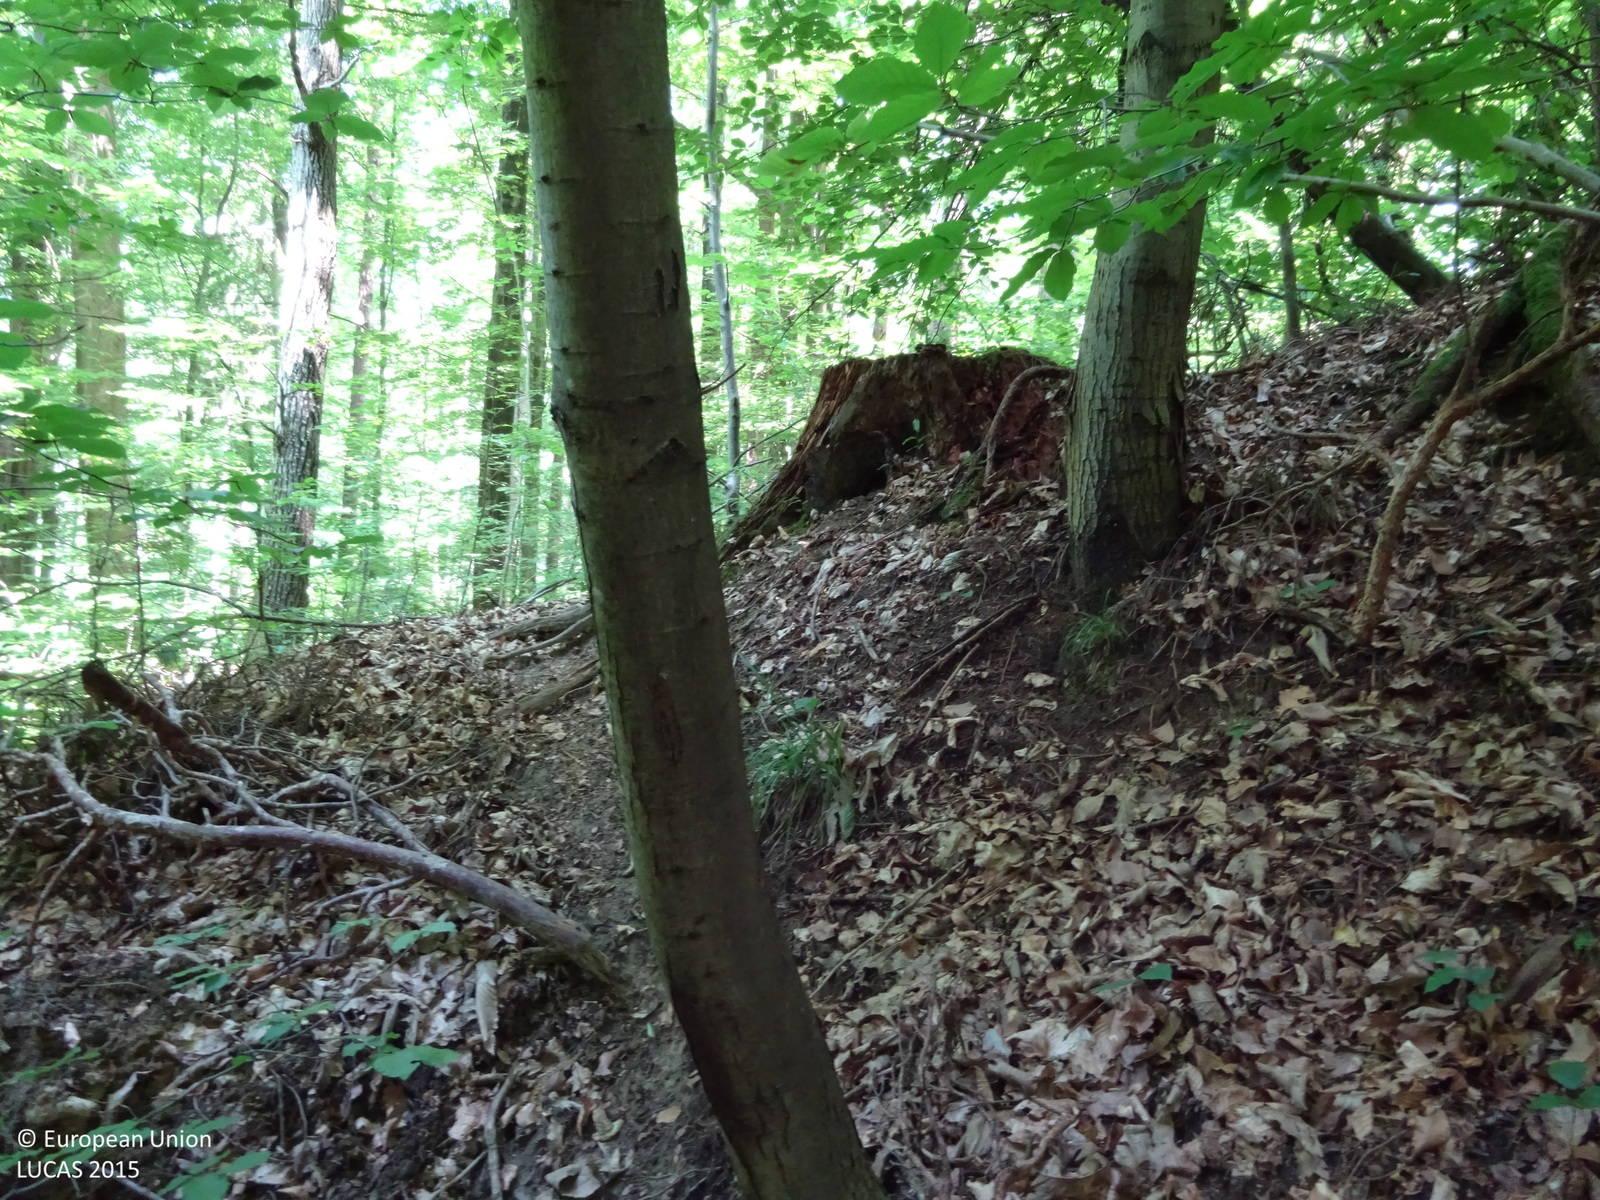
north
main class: Woodland
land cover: Broadleaved woodland
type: mountainous beech forest
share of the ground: > 75 %
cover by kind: broadleaved forest trees 100 %
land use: Forestry
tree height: > 5 m
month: July
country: AT
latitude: 46.8633
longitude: 16.1007
